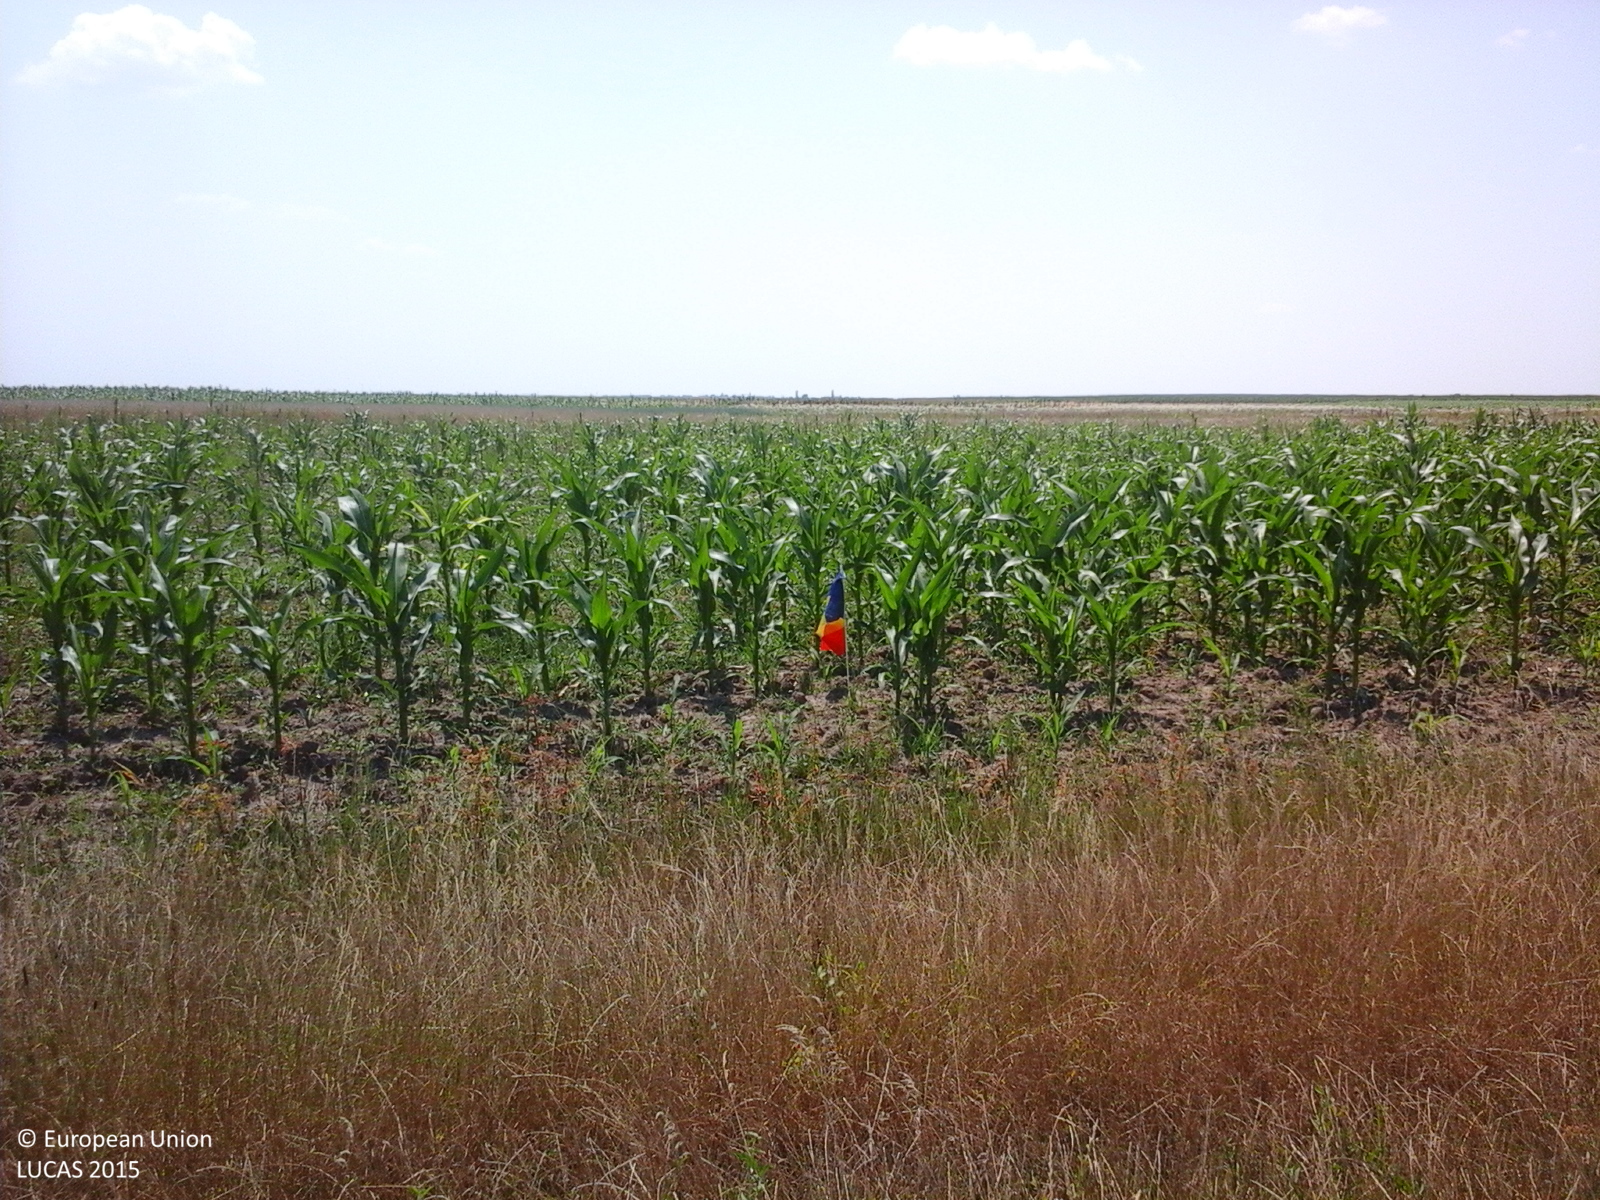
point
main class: Cropland
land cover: Maize
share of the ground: 50 - 75 %
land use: Agriculture (excluding fallow land and kitchen gardens)
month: July
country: RO
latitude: 44.4638
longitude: 25.3599
